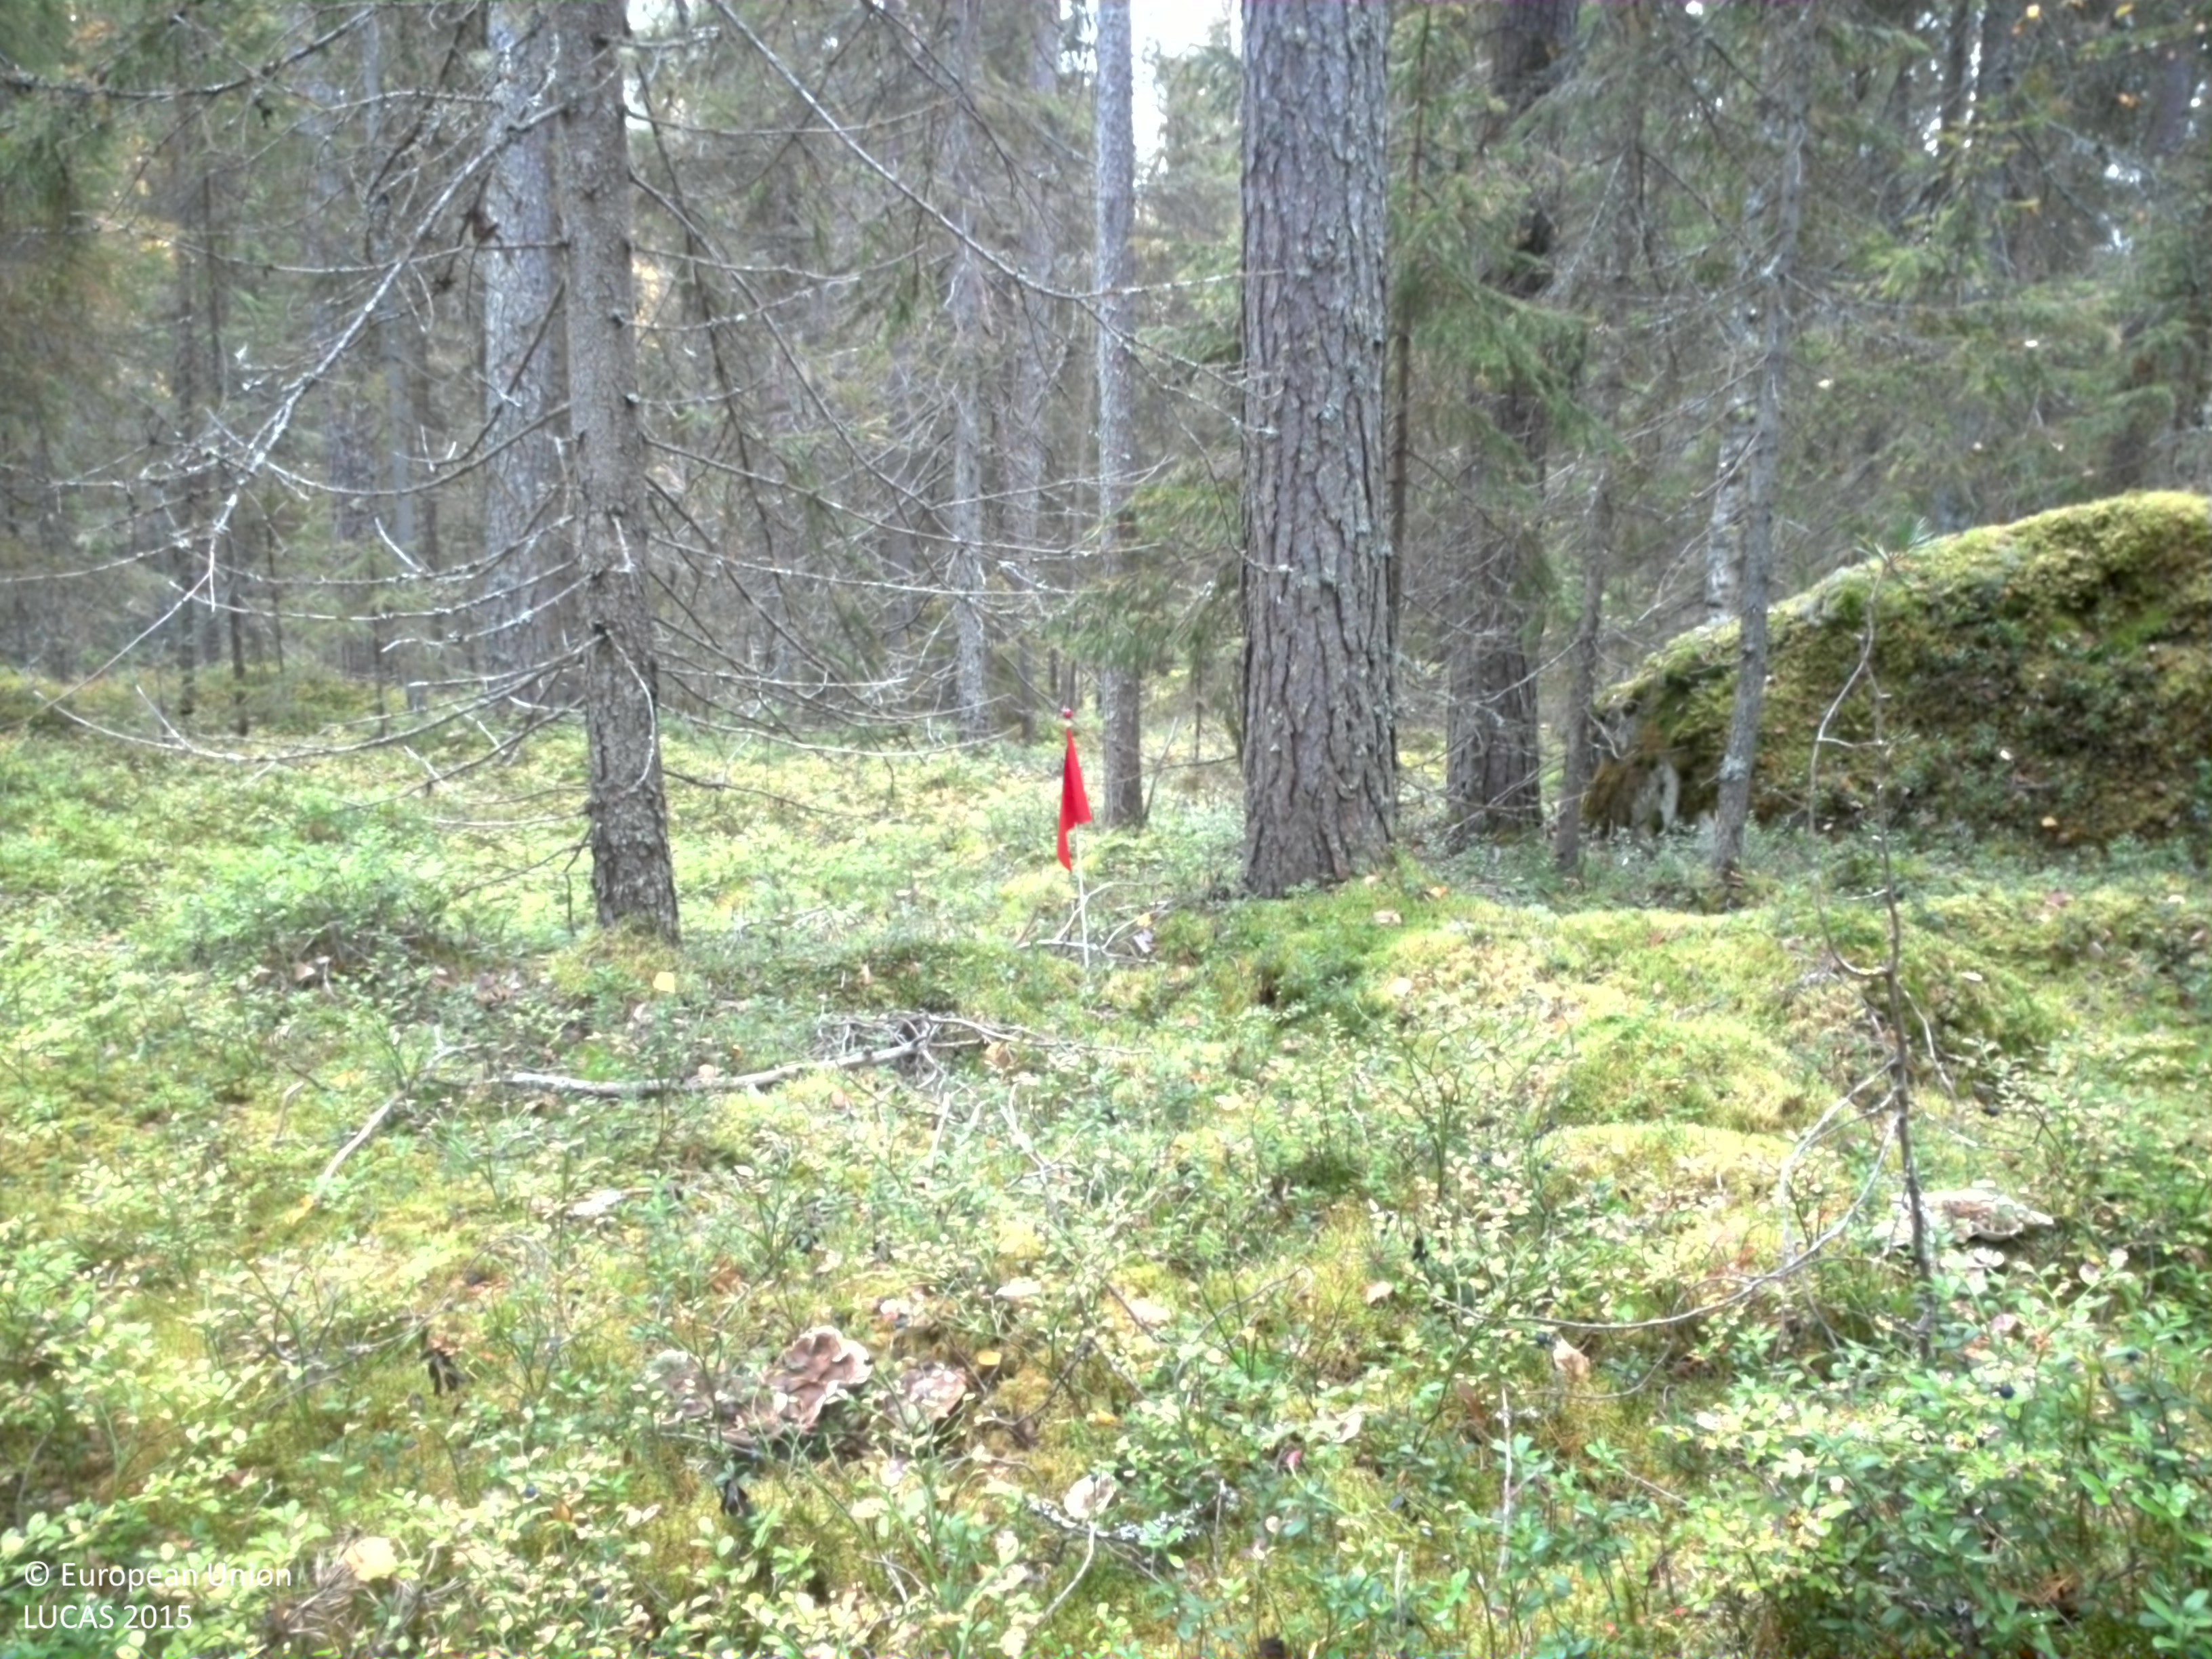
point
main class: Woodland
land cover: Pine dominated coniferous woodland
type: boreal forest
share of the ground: 25 - 50 %
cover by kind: shrubs 65 %, coniferous forest trees 35 %
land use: Forestry
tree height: > 5 m
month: September
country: SE
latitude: 65.8594
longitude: 21.8279
